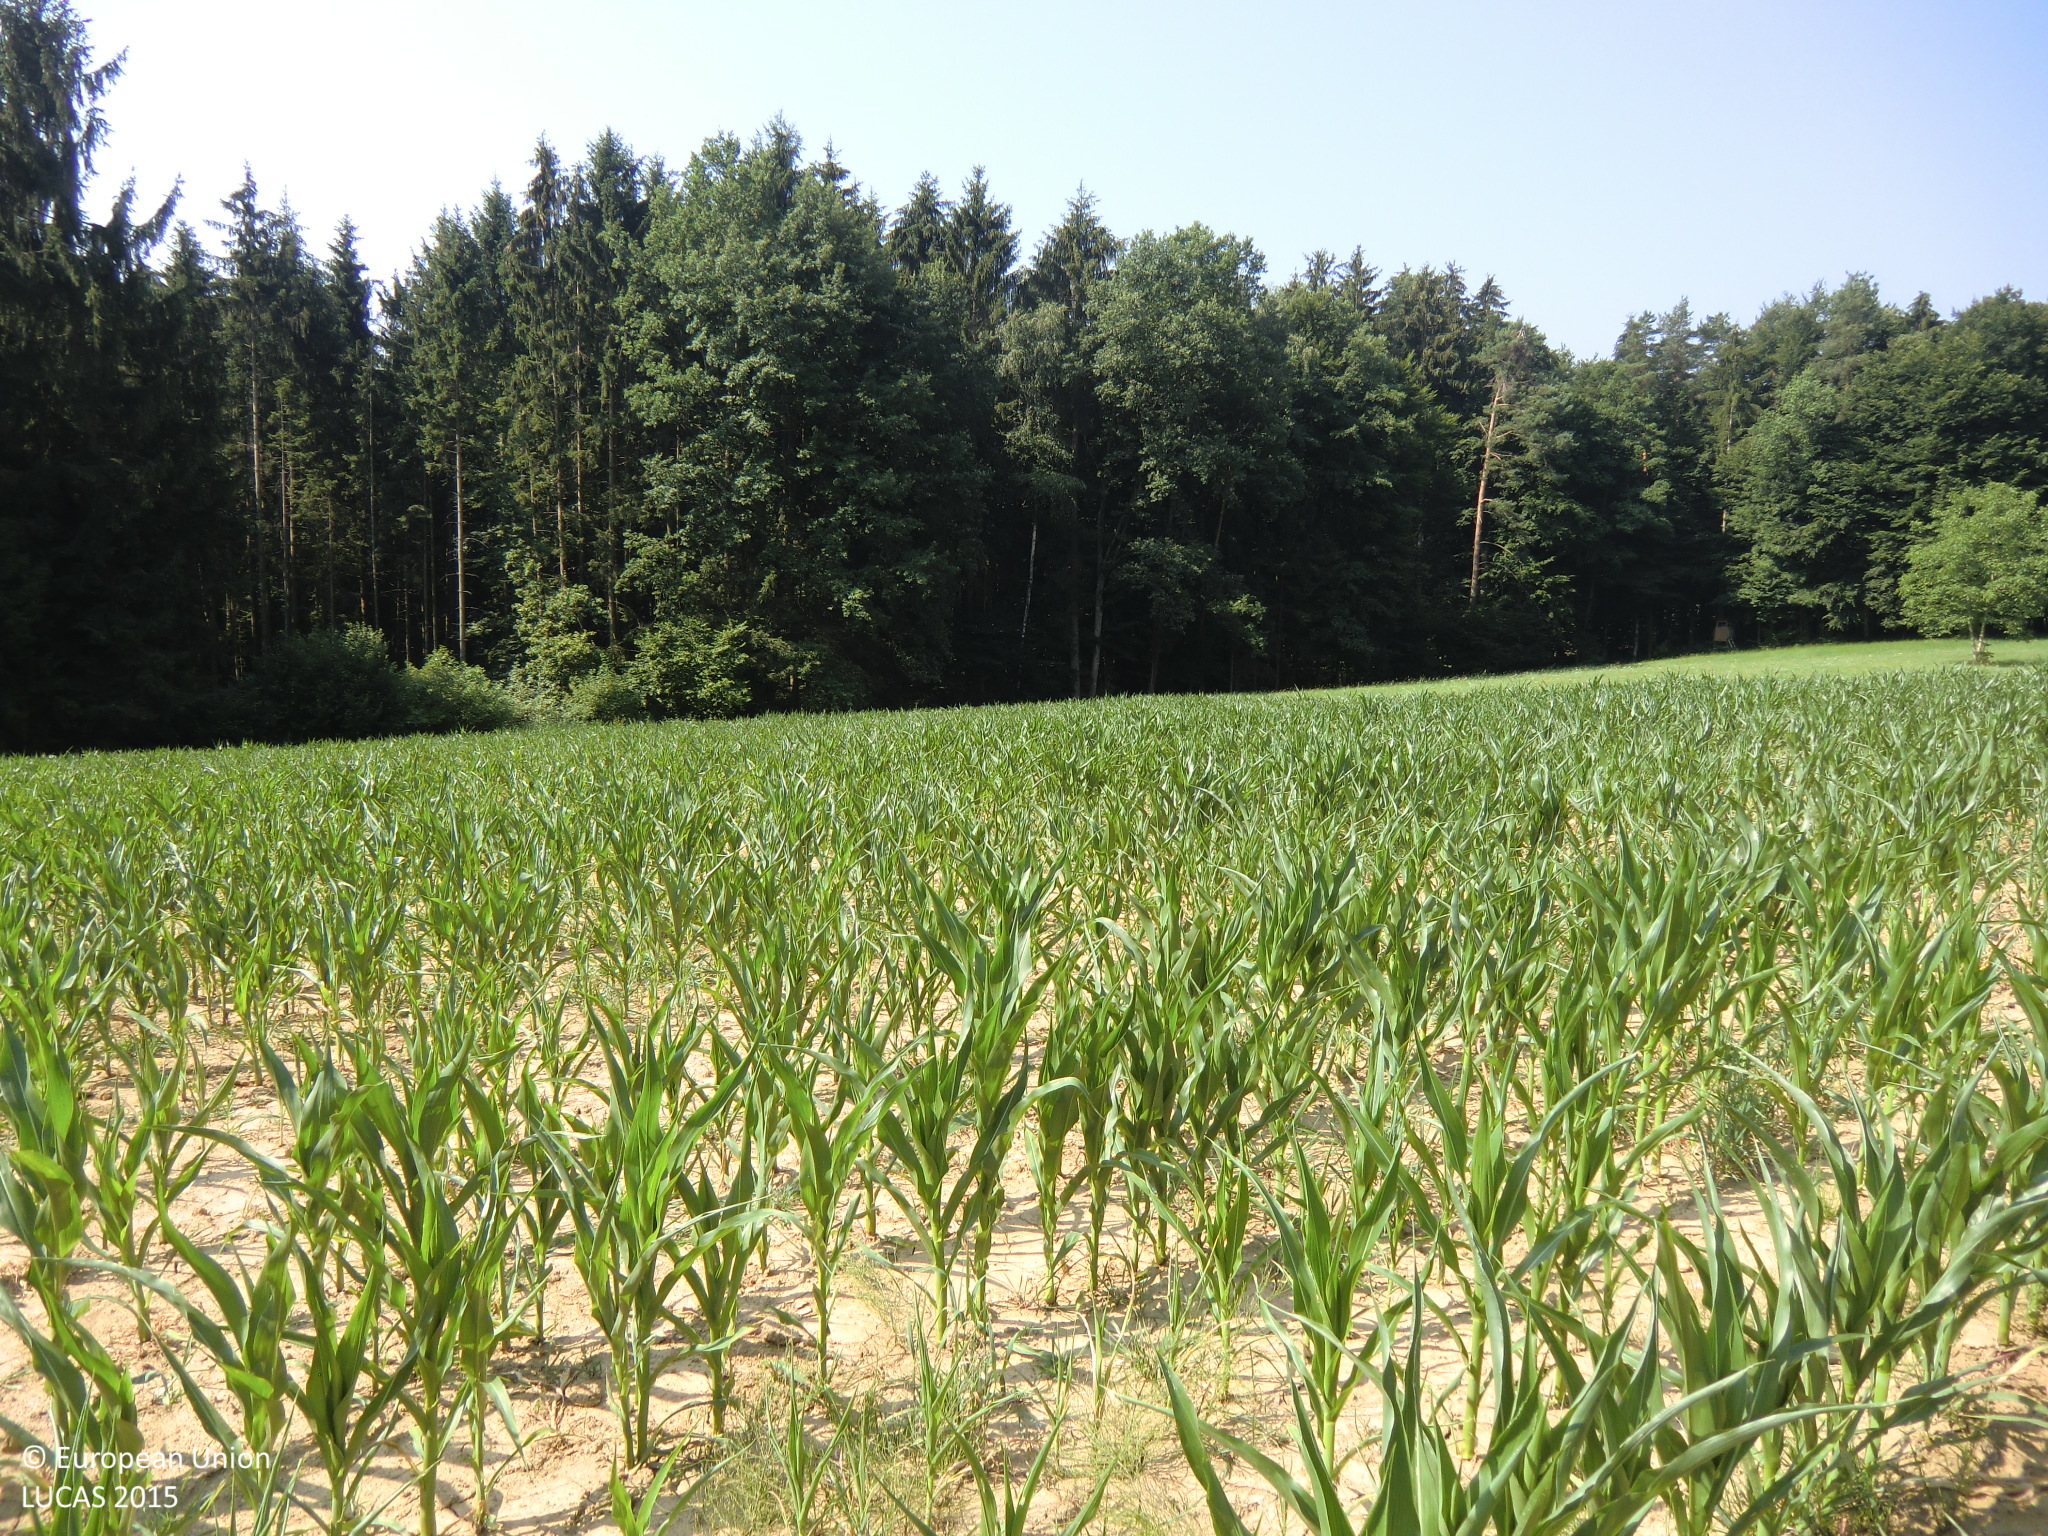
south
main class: Cropland
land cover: Maize
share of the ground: 50 - 75 %
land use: Agriculture (excluding fallow land and kitchen gardens)
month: July
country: AT
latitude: 47.1539
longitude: 15.7379
